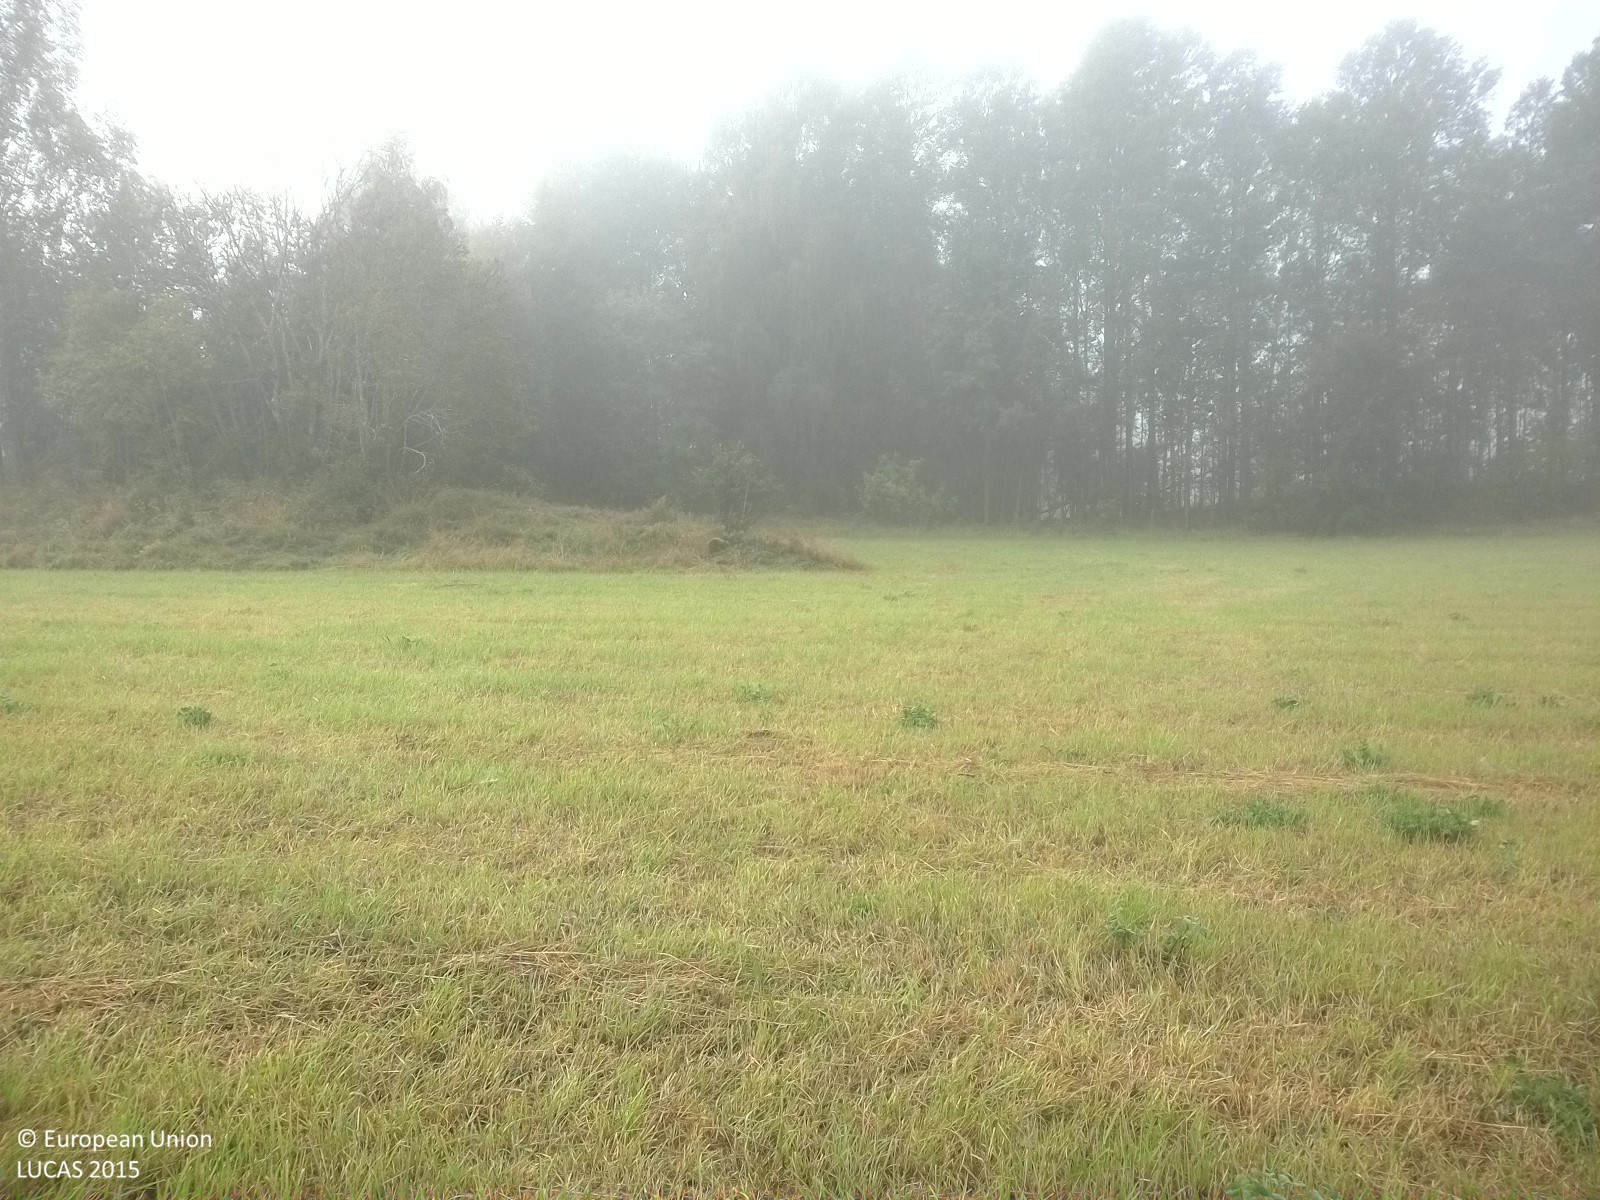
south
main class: Grassland
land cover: Grassland without tree/shrub cover
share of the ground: > 75 %
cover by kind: herbaceous plants 100 %
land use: Agriculture (excluding fallow land and kitchen gardens)
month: August
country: SE
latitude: 59.3447
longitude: 15.2137
